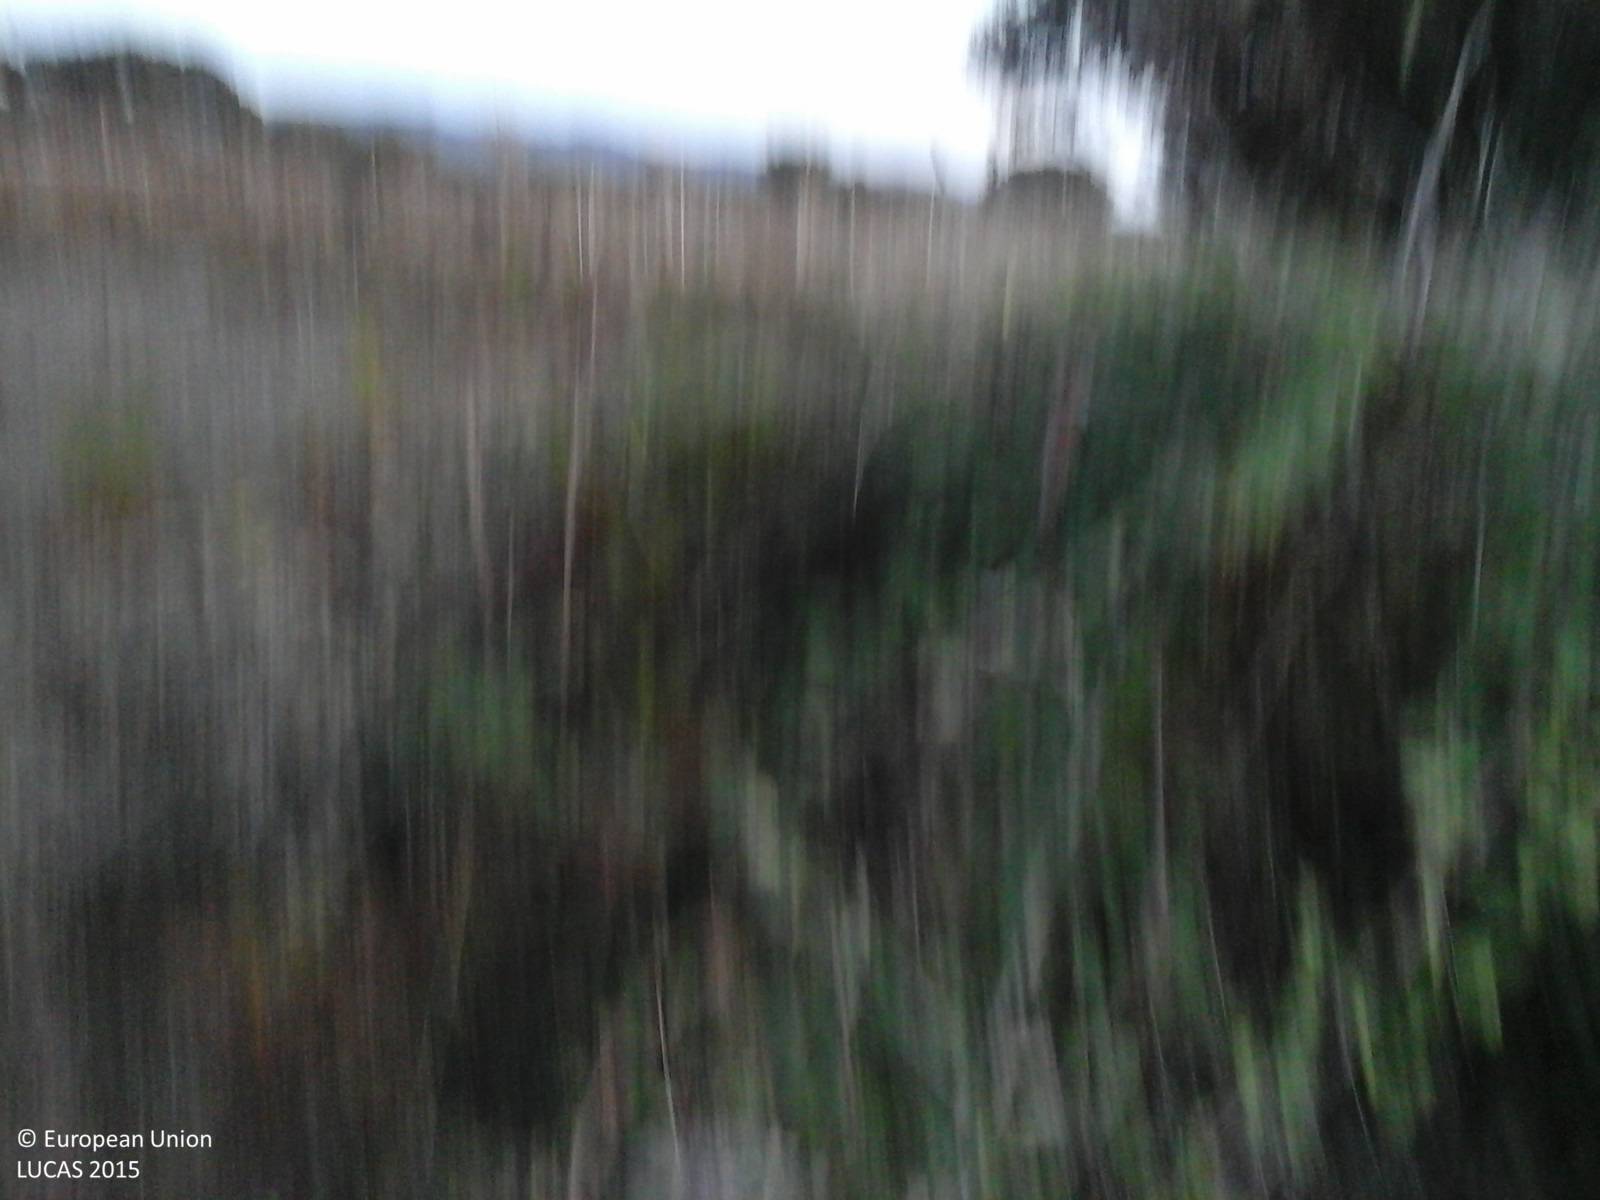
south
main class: Grassland
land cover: Spontaneously vegetated surfaces
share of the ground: > 75 %
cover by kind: herbaceous plants 100 %
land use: Agriculture (excluding fallow land and kitchen gardens)
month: October
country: IT
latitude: 40.2752
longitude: 8.5843
